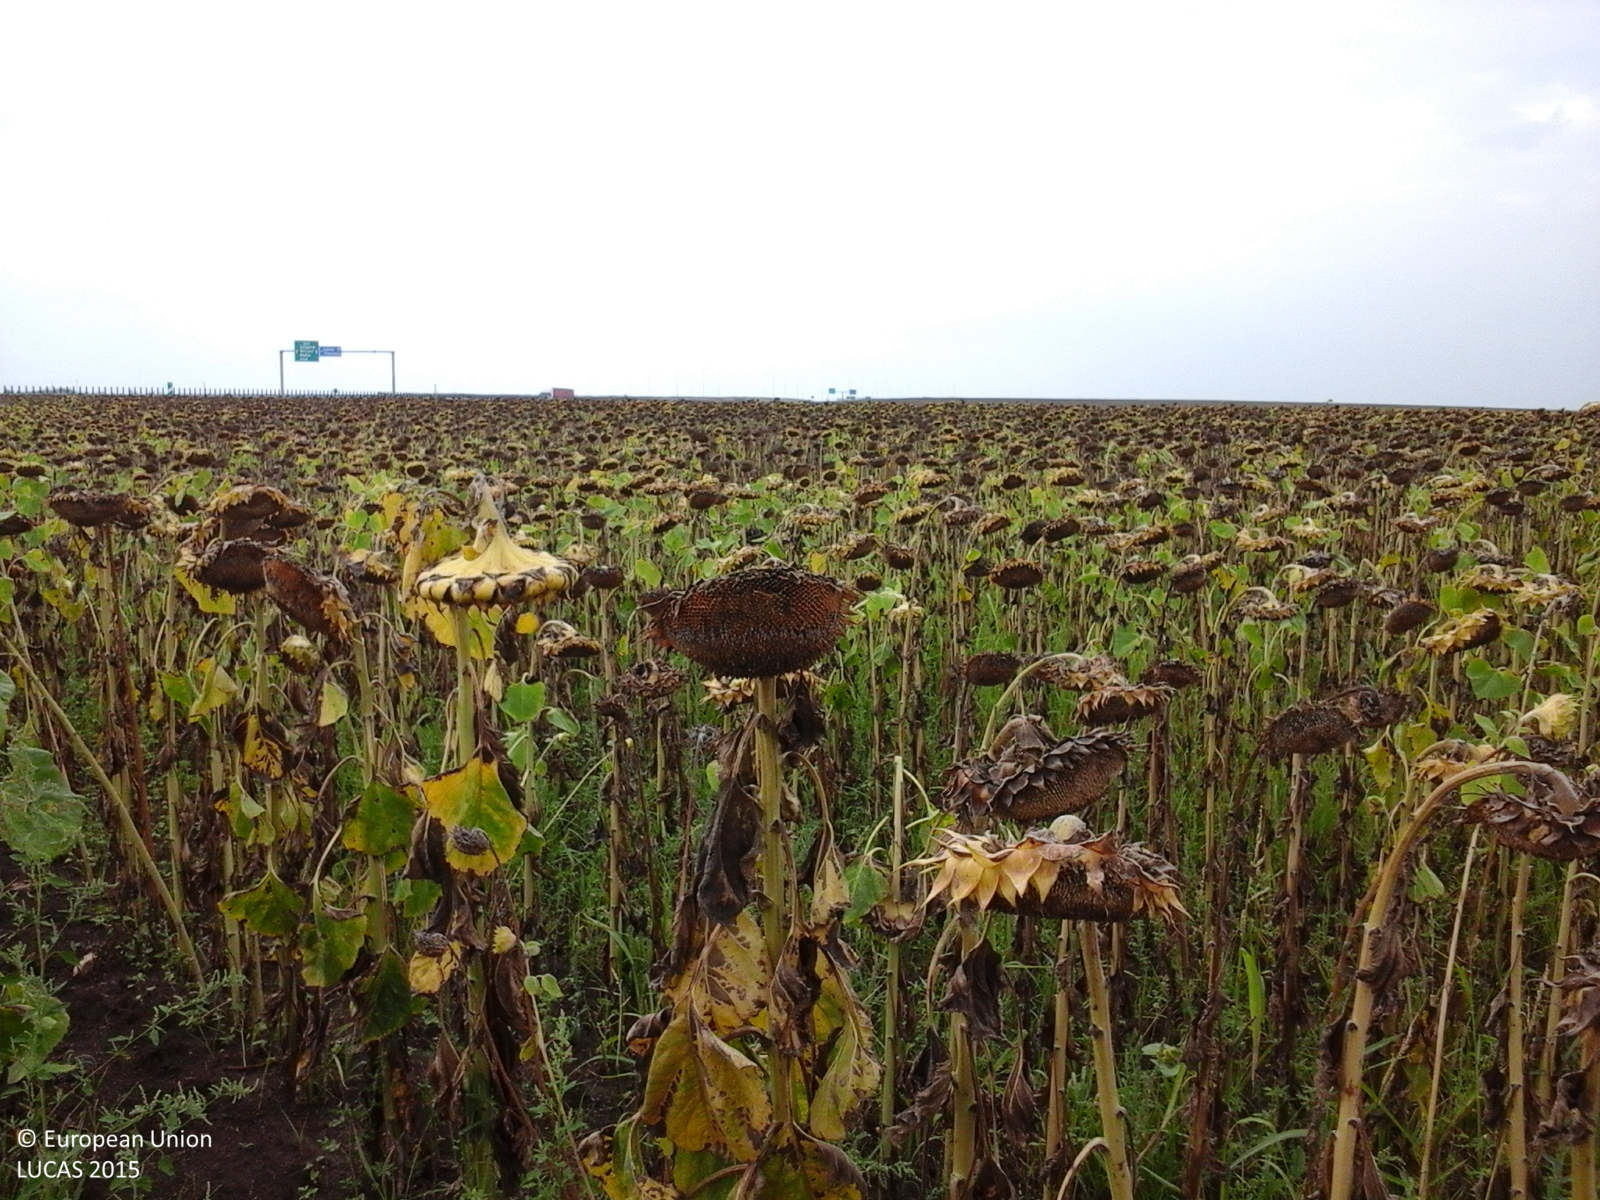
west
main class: Cropland
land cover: Sunflower
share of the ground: > 75 %
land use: Agriculture (excluding fallow land and kitchen gardens)
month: August
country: RO
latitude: 45.8565
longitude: 21.3273
